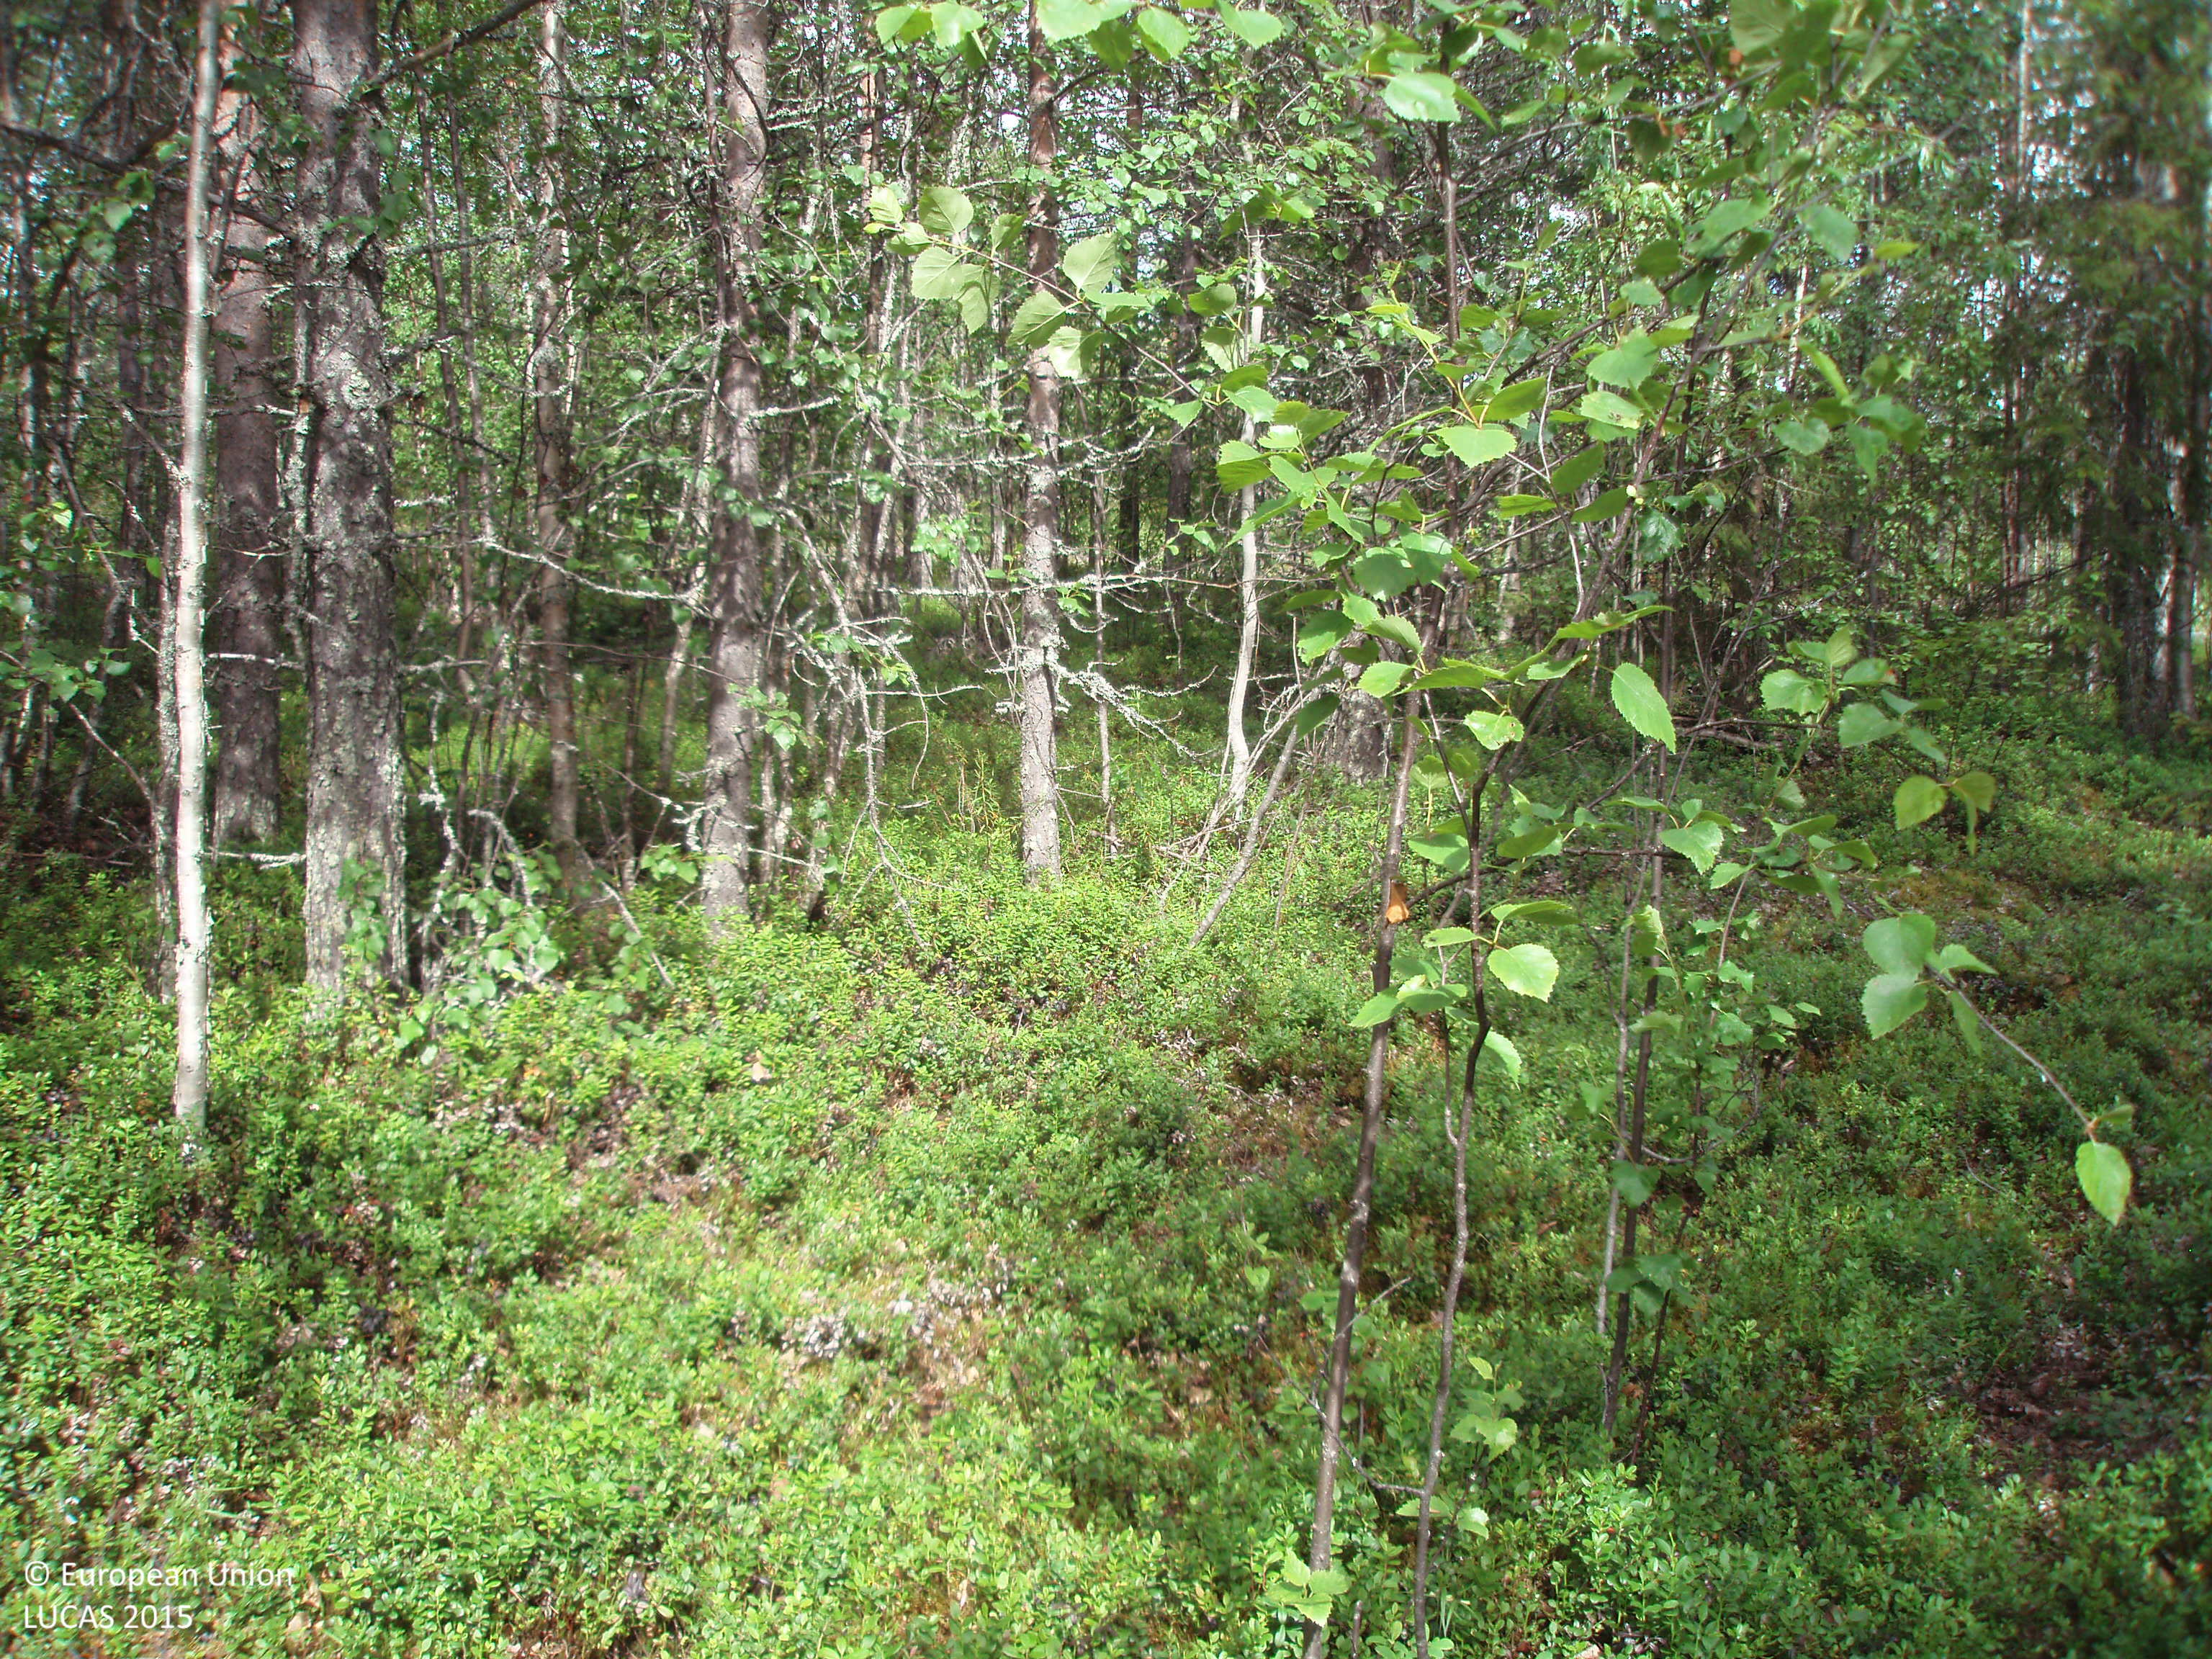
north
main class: Woodland
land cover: Pine dominated mixed woodland
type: boreal forest
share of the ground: > 75 %
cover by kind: coniferous forest trees 40 %, broadleaved forest trees 35 %, shrubs 25 %
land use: Forestry
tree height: > 5 m
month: July
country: FI
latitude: 66.9890
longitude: 28.0734
